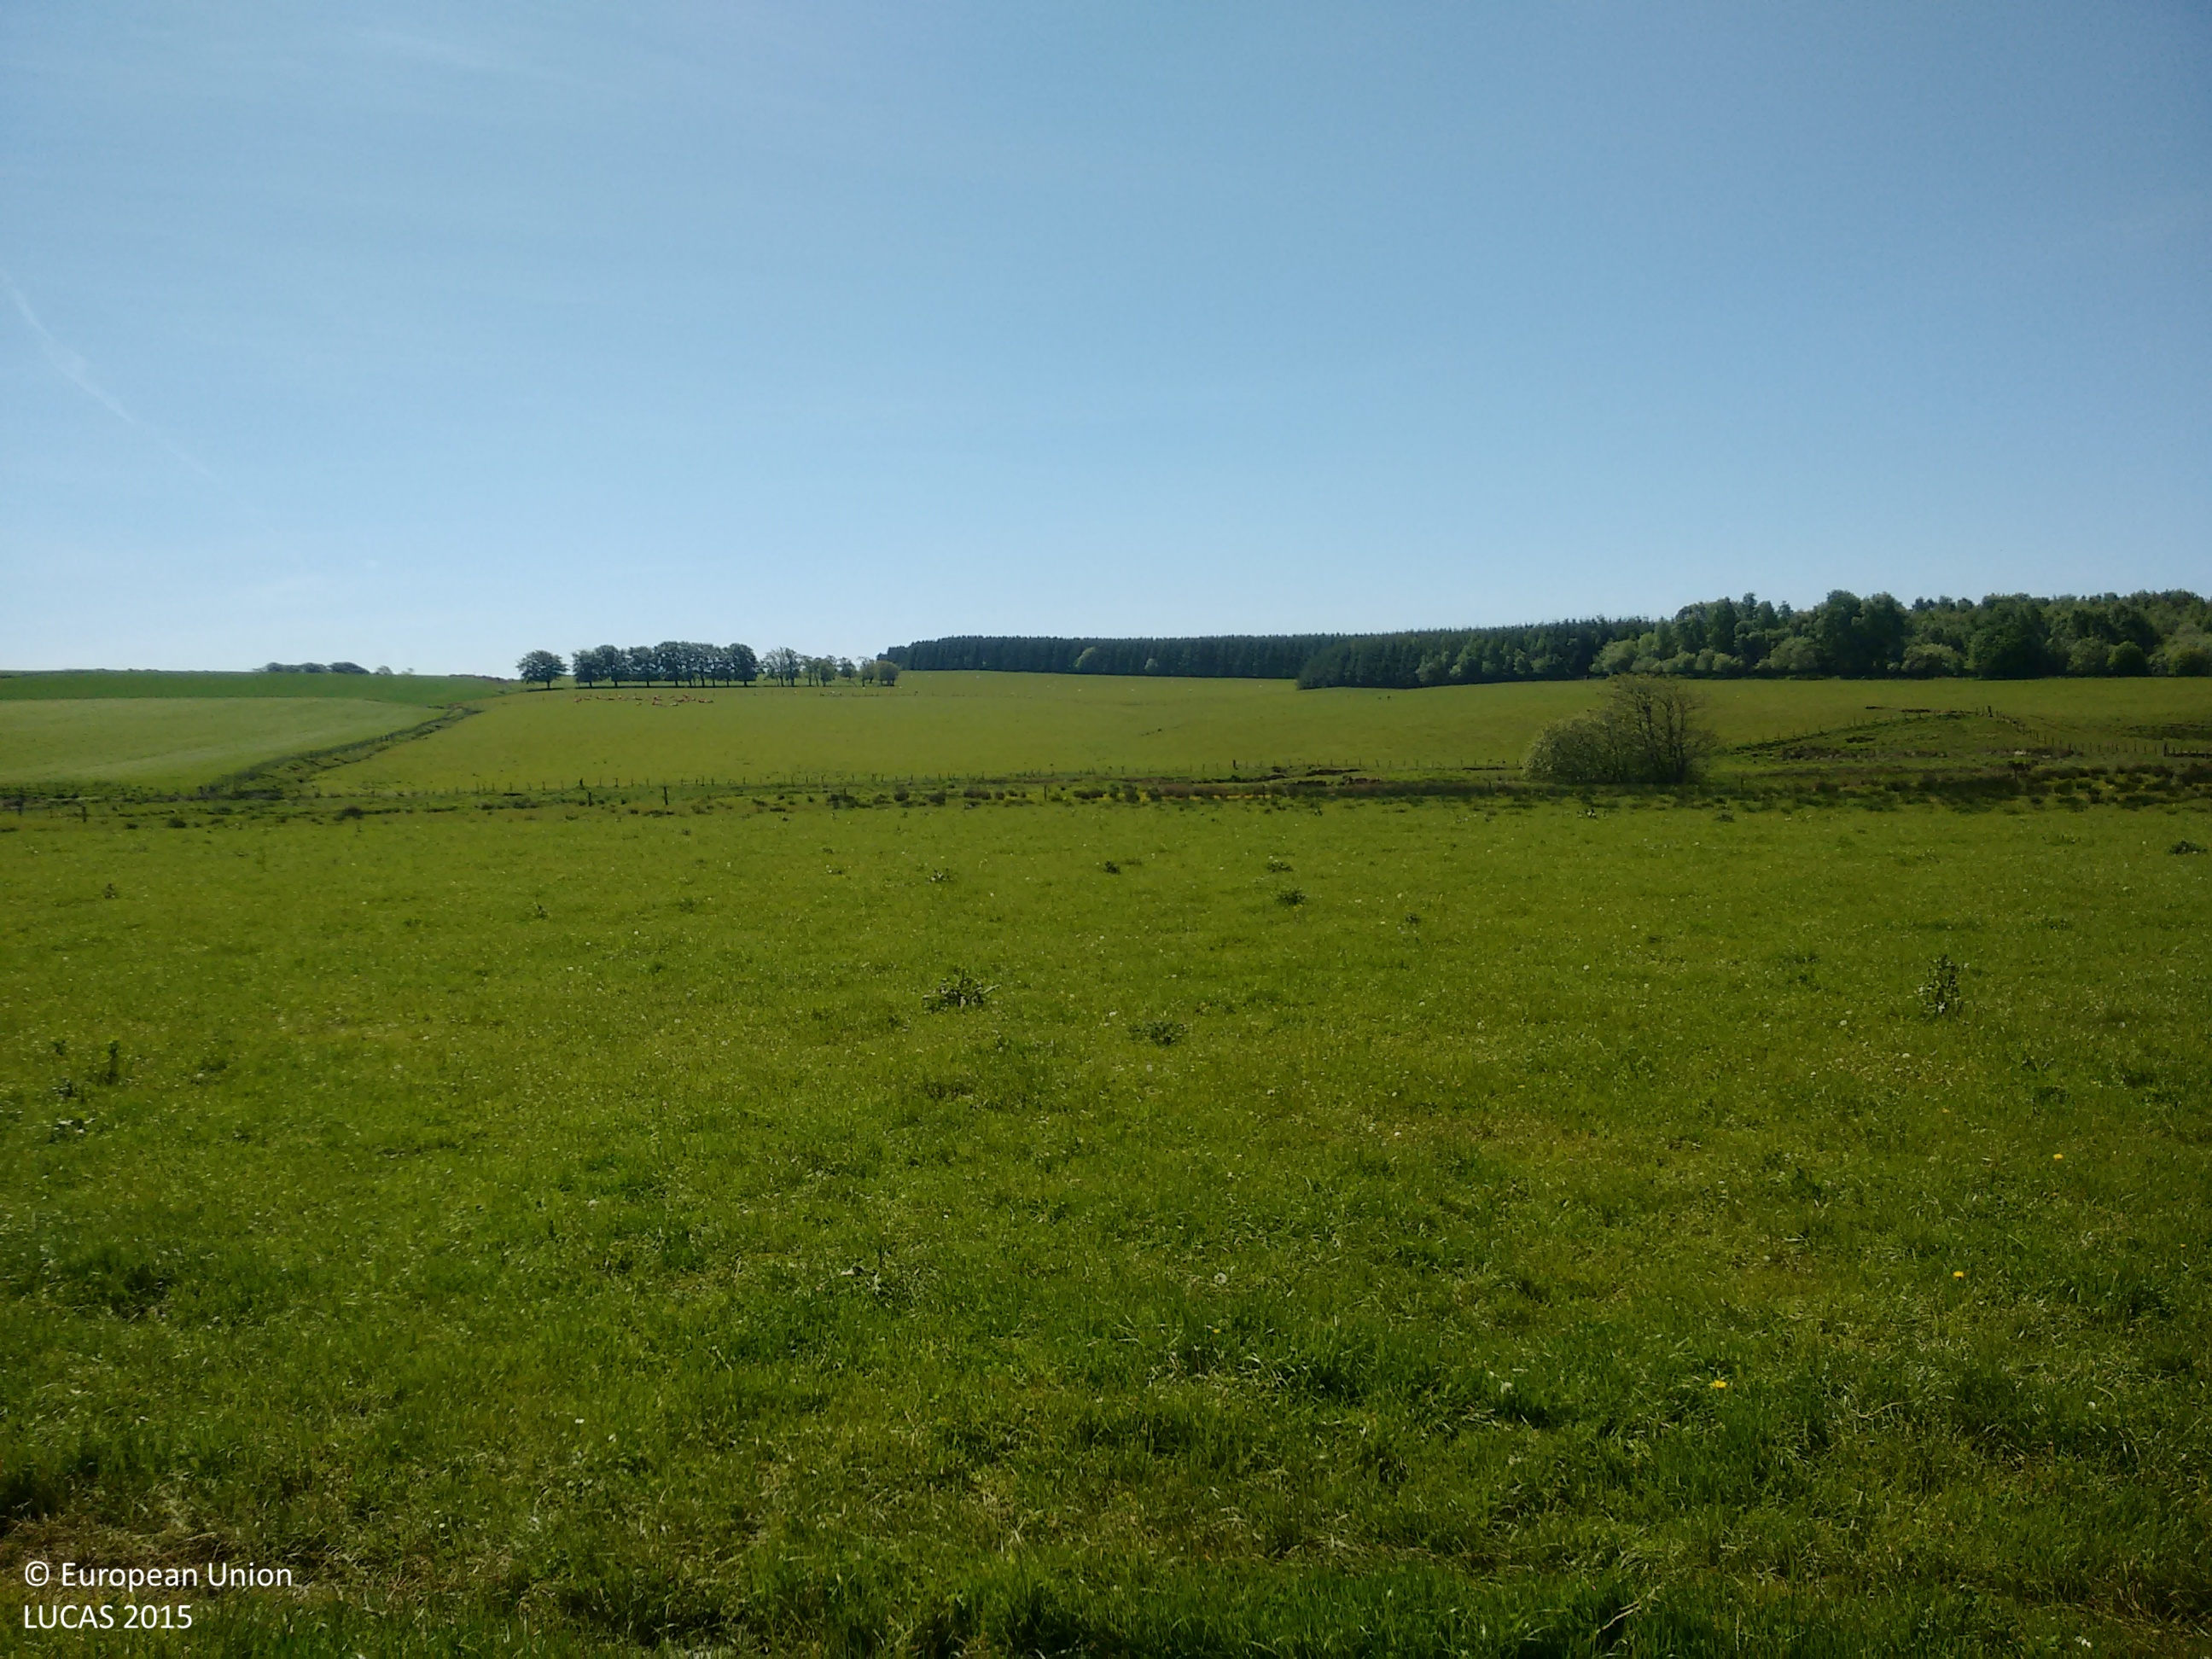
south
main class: Grassland
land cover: Grassland without tree/shrub cover
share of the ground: > 75 %
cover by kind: herbaceous plants 75 %, lichens and mosses 25 %
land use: Agriculture (excluding fallow land and kitchen gardens)
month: June
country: GB
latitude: 55.6836
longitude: -3.5508
